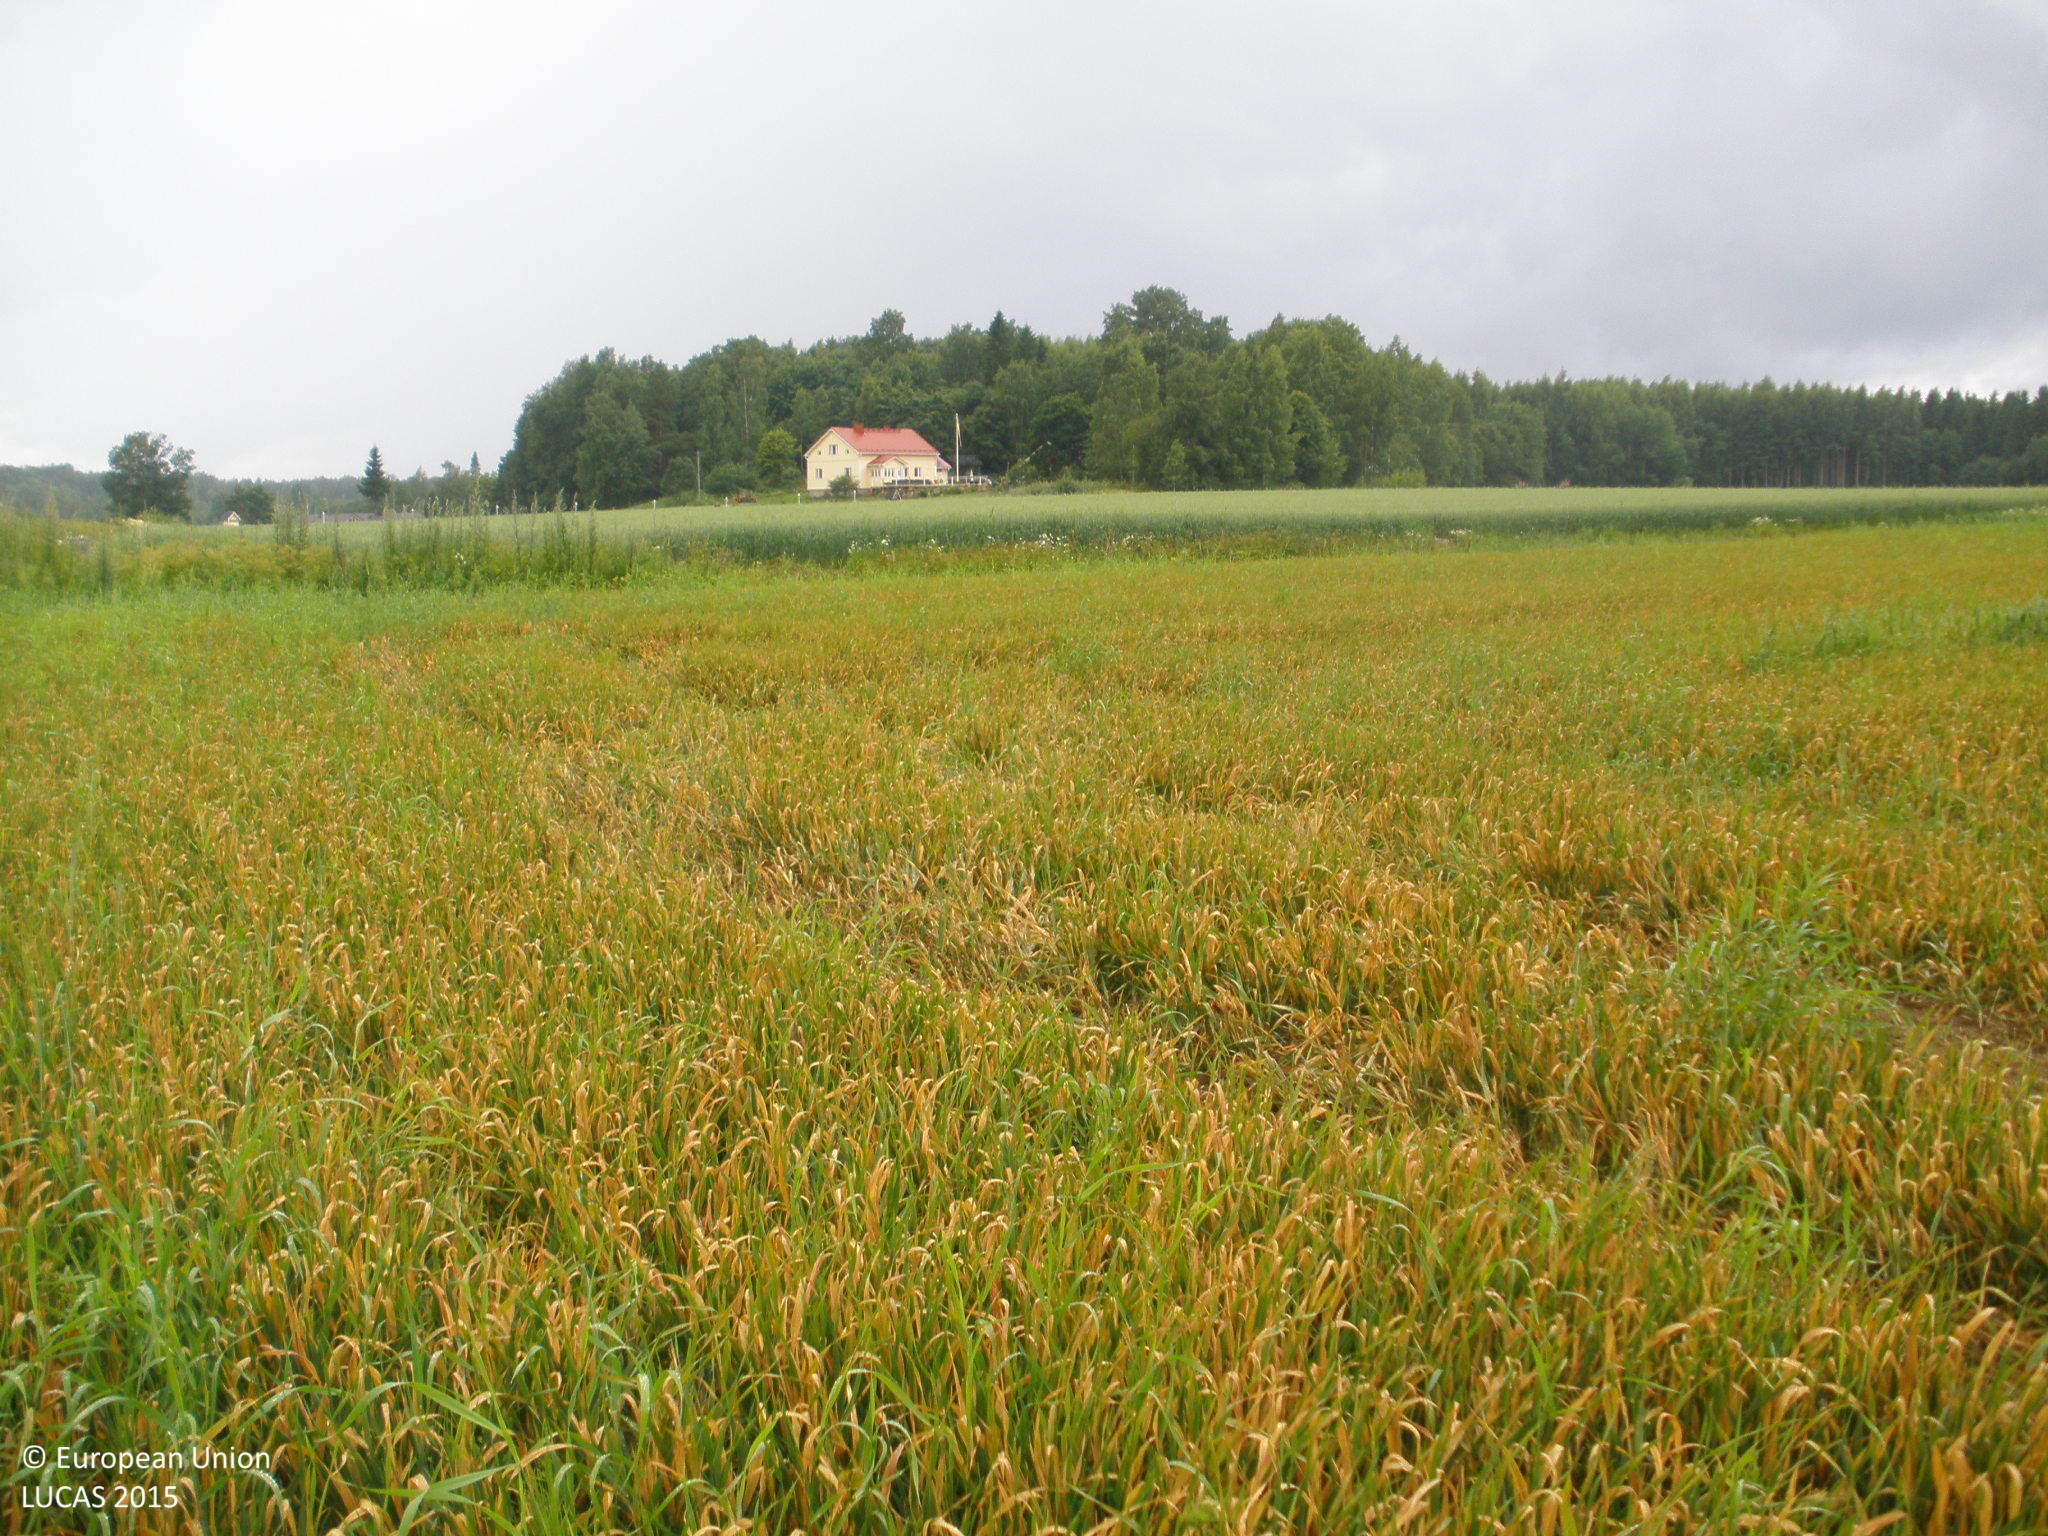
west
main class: Cropland
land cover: Barley
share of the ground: 25 - 50 %
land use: Agriculture (excluding fallow land and kitchen gardens)
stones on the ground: < 10 %
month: July
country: FI
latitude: 61.1606
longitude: 24.7705
